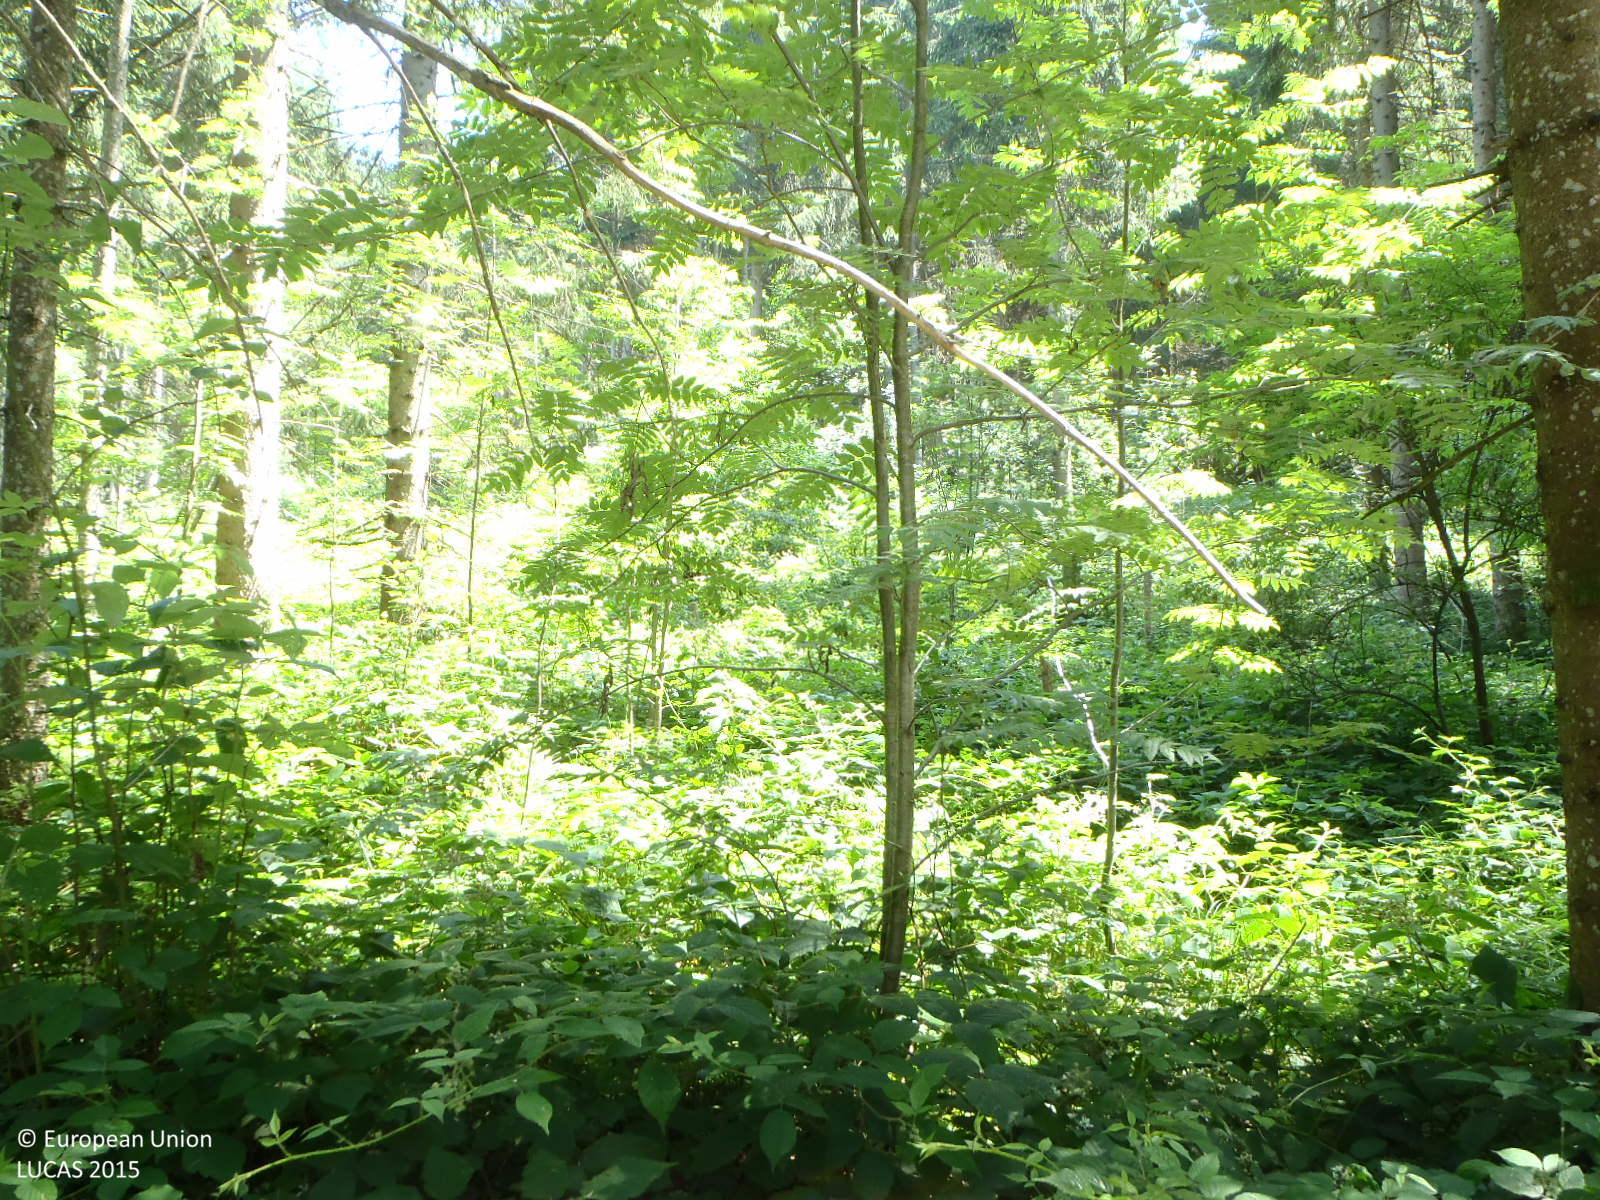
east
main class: Woodland
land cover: Other coniferous woodland
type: alpine coniferous forest
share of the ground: > 75 %
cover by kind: coniferous forest trees 75 %, broadleaved forest trees 25 %
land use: Forestry
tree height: > 5 m
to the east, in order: Other coniferous woodland; Tracks; Spruce dominated coniferous woodland; Tracks; Spruce dominated coniferous woodland; Paved roads, cycling and walking lanes; Spruce dominated coniferous woodland; Shrubland without tree cover; Paved roads, cycling and walking lanes; Grassland without tree/shrub cover; Paved roads, cycling and walking lanes; Grassland without tree/shrub cover
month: July
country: AT
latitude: 47.4778
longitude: 12.3736
